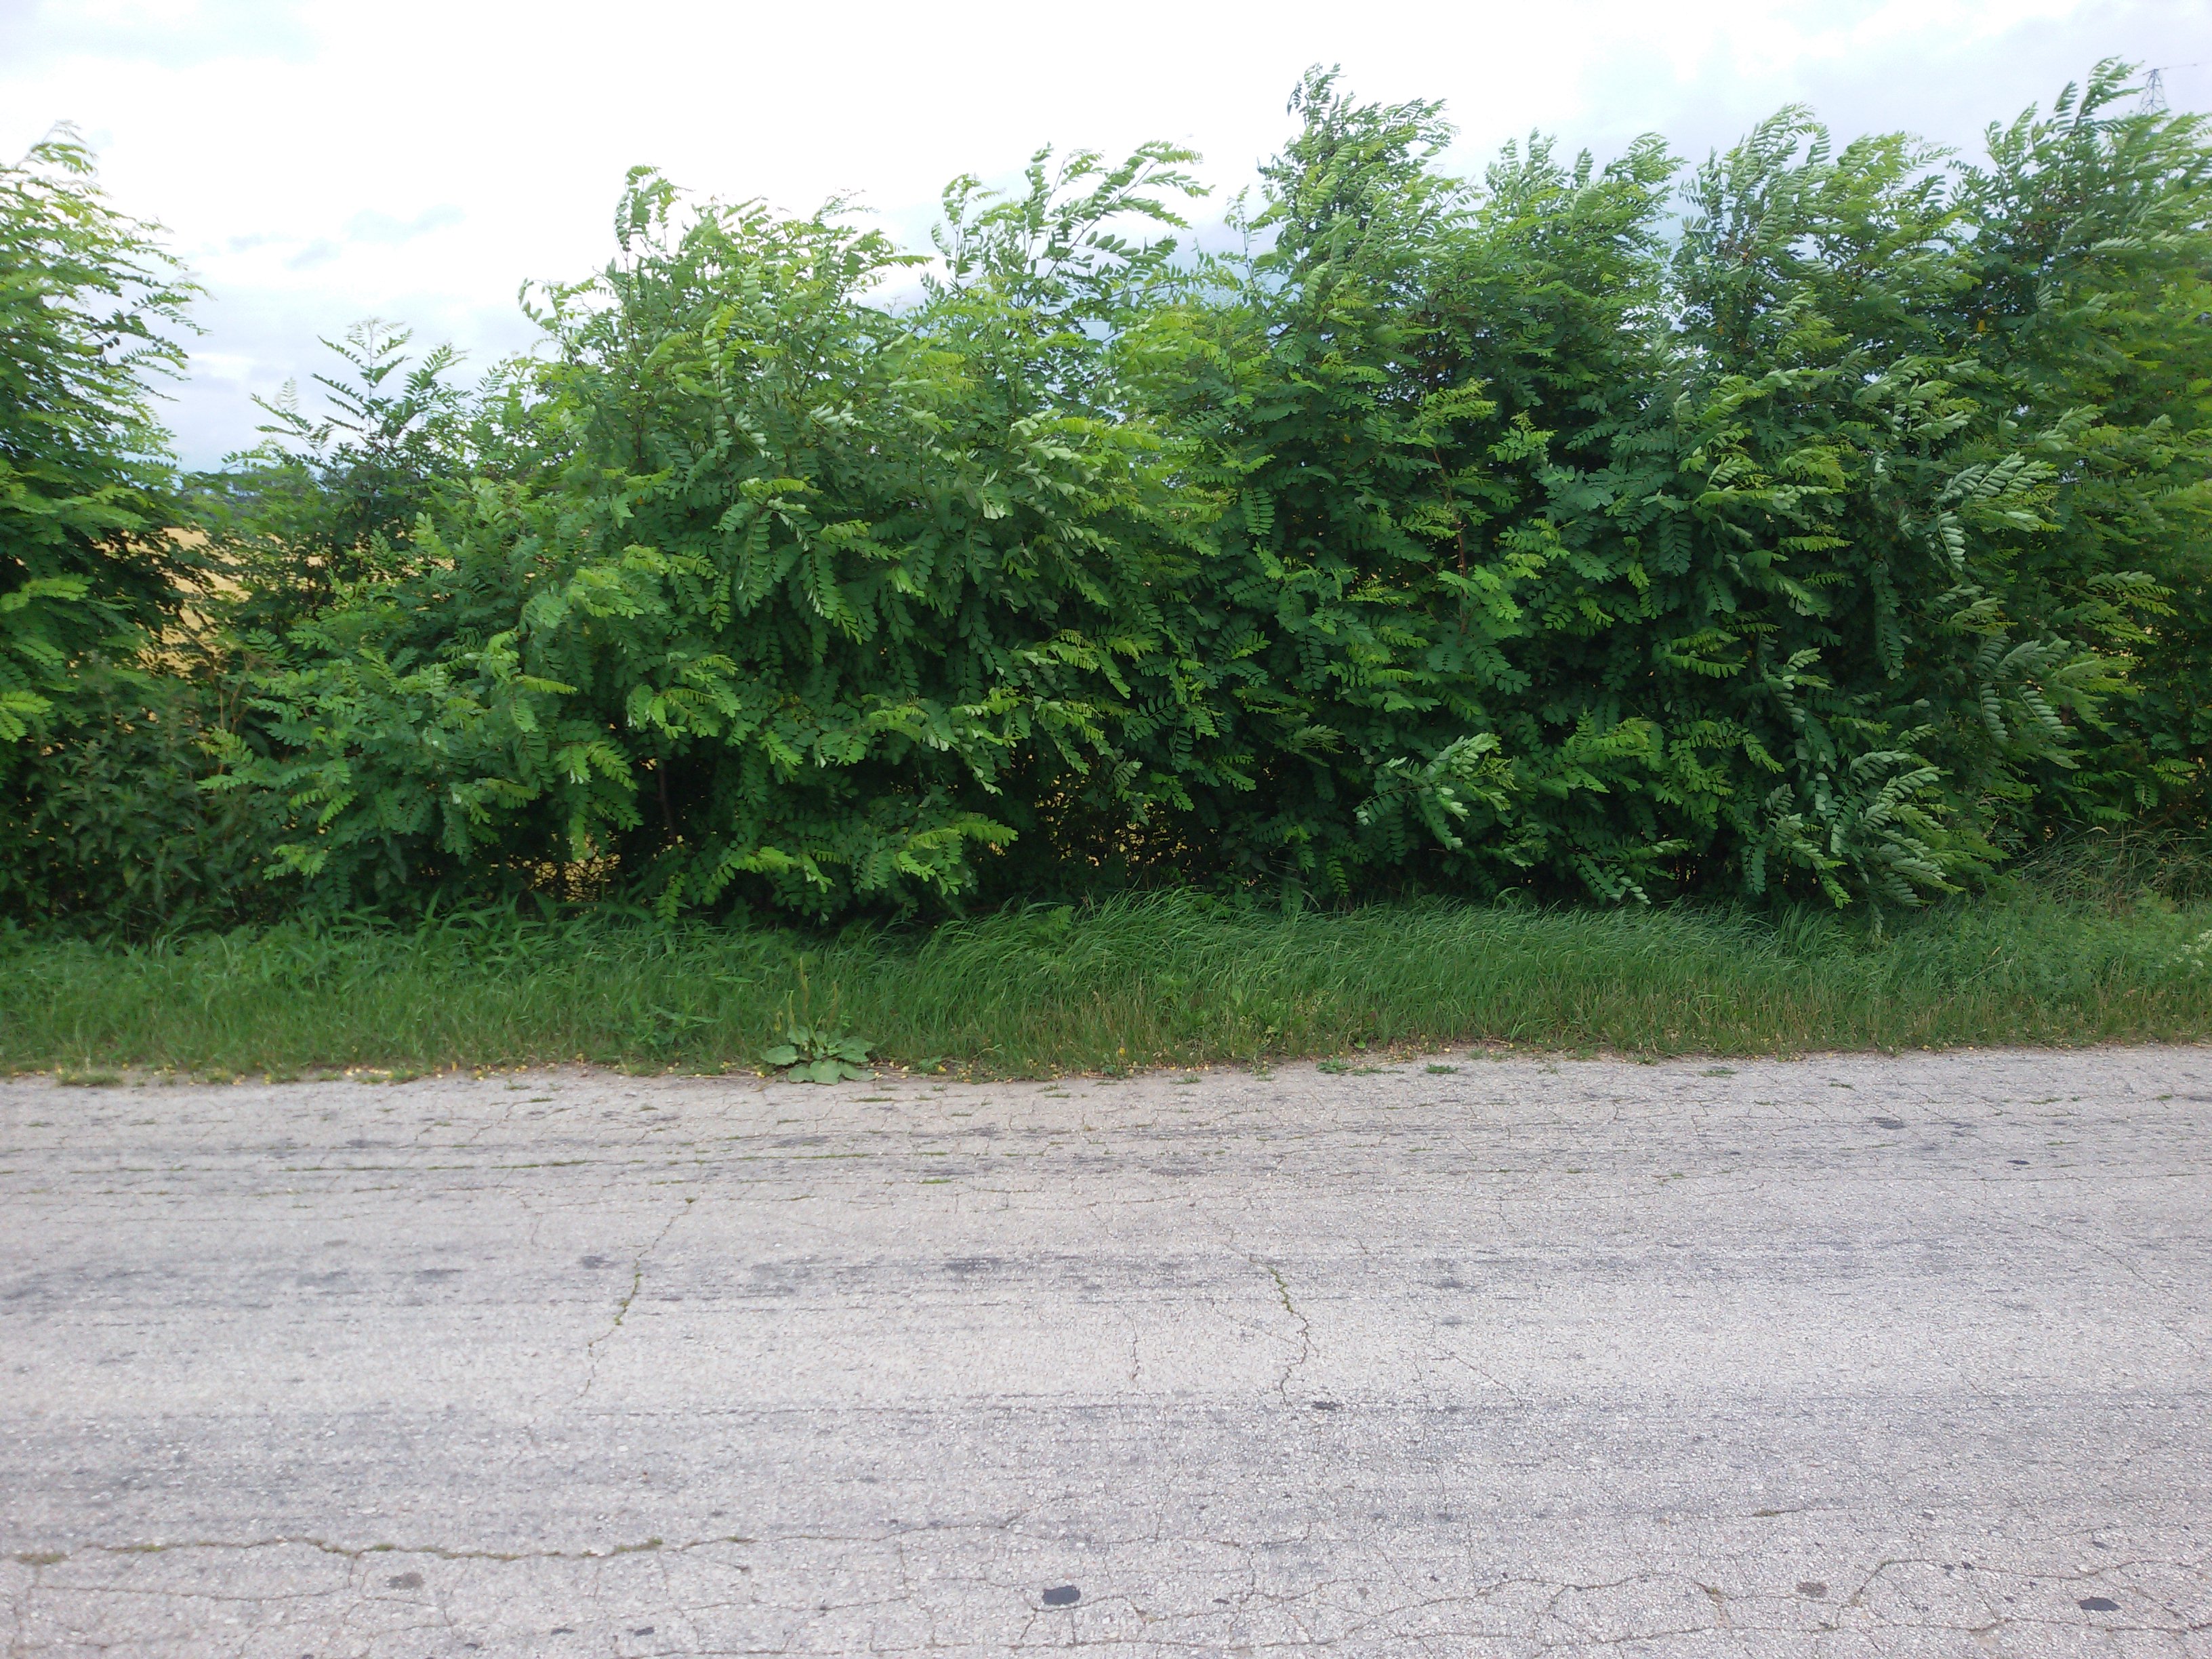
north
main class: Cropland
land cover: Maize
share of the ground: > 75 %
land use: Agriculture (excluding fallow land and kitchen gardens)
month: July
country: PL
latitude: 52.9471
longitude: 17.5878
